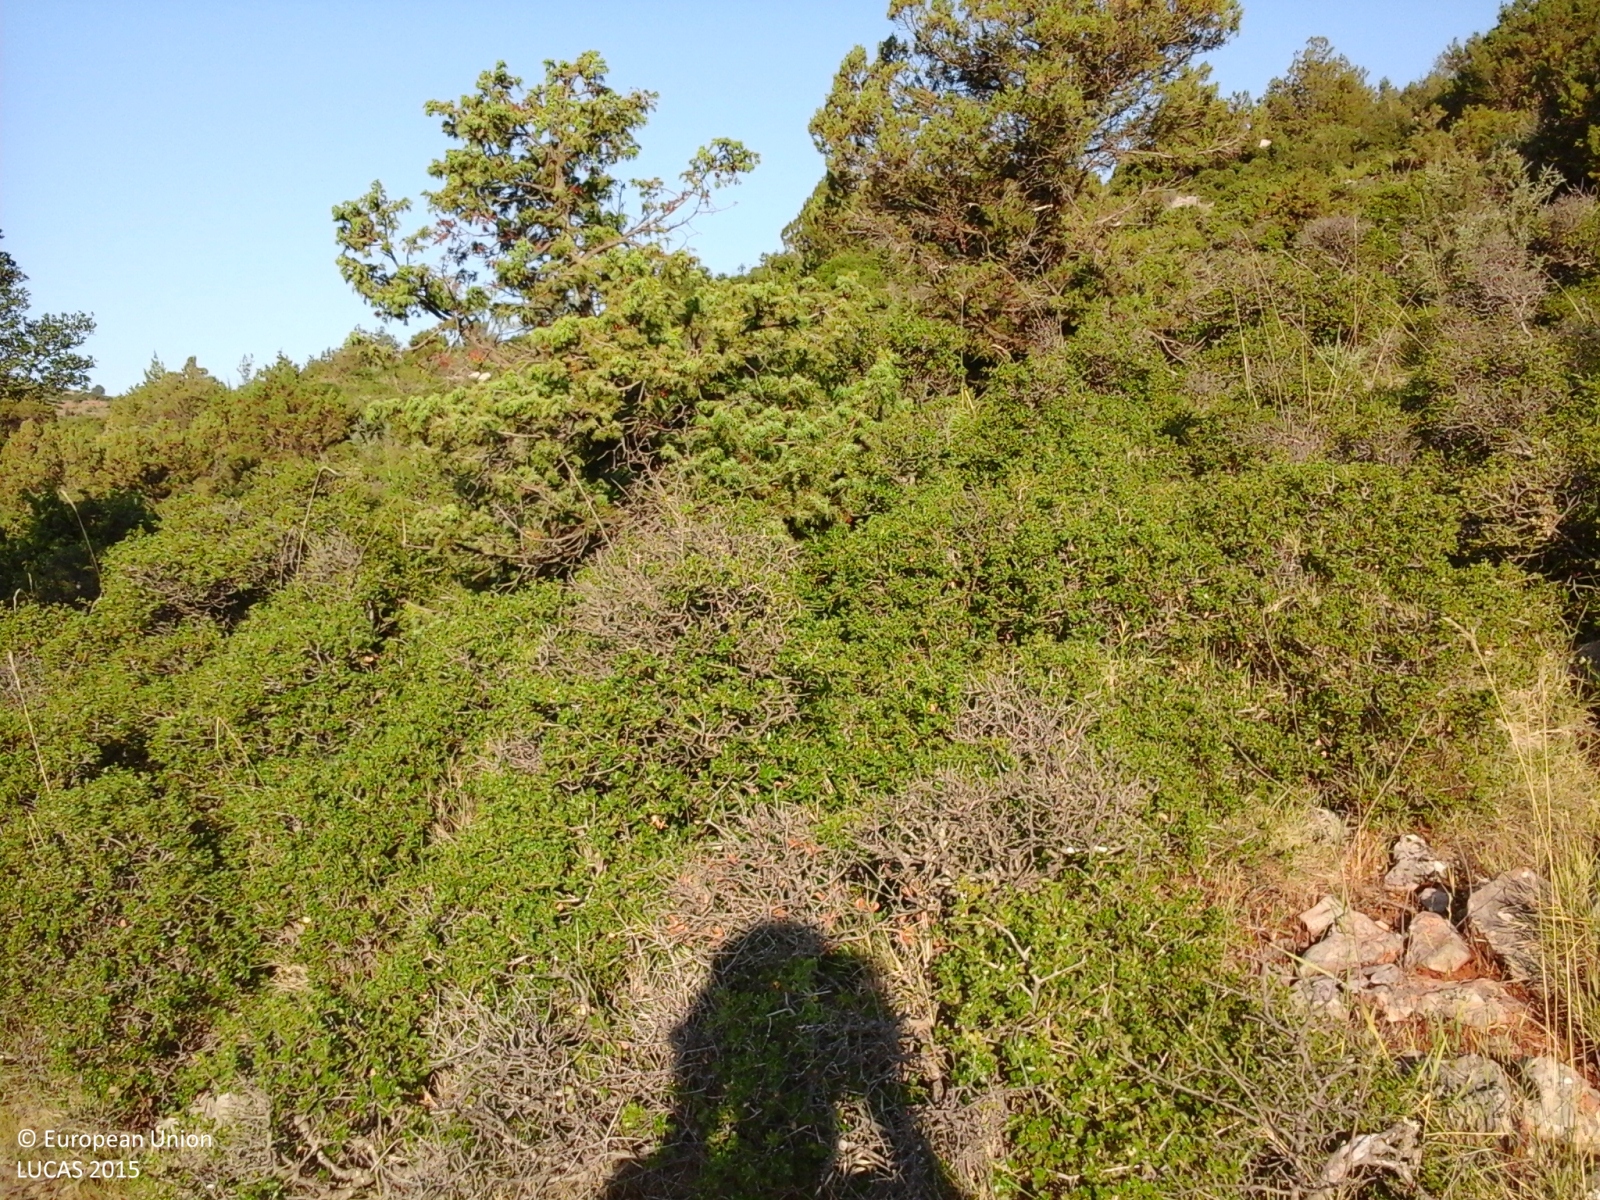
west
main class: Shrubland
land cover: Shrubland with sparse tree cover
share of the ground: > 75 %
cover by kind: shrubs 75 %, herbaceous plants 10 %, unconsolidated bare surface 10 %, coniferous forest trees 5 %
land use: Semi-natural and natural areas not in use
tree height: > 5 m
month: June
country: GR
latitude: 38.4580
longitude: 22.5010
